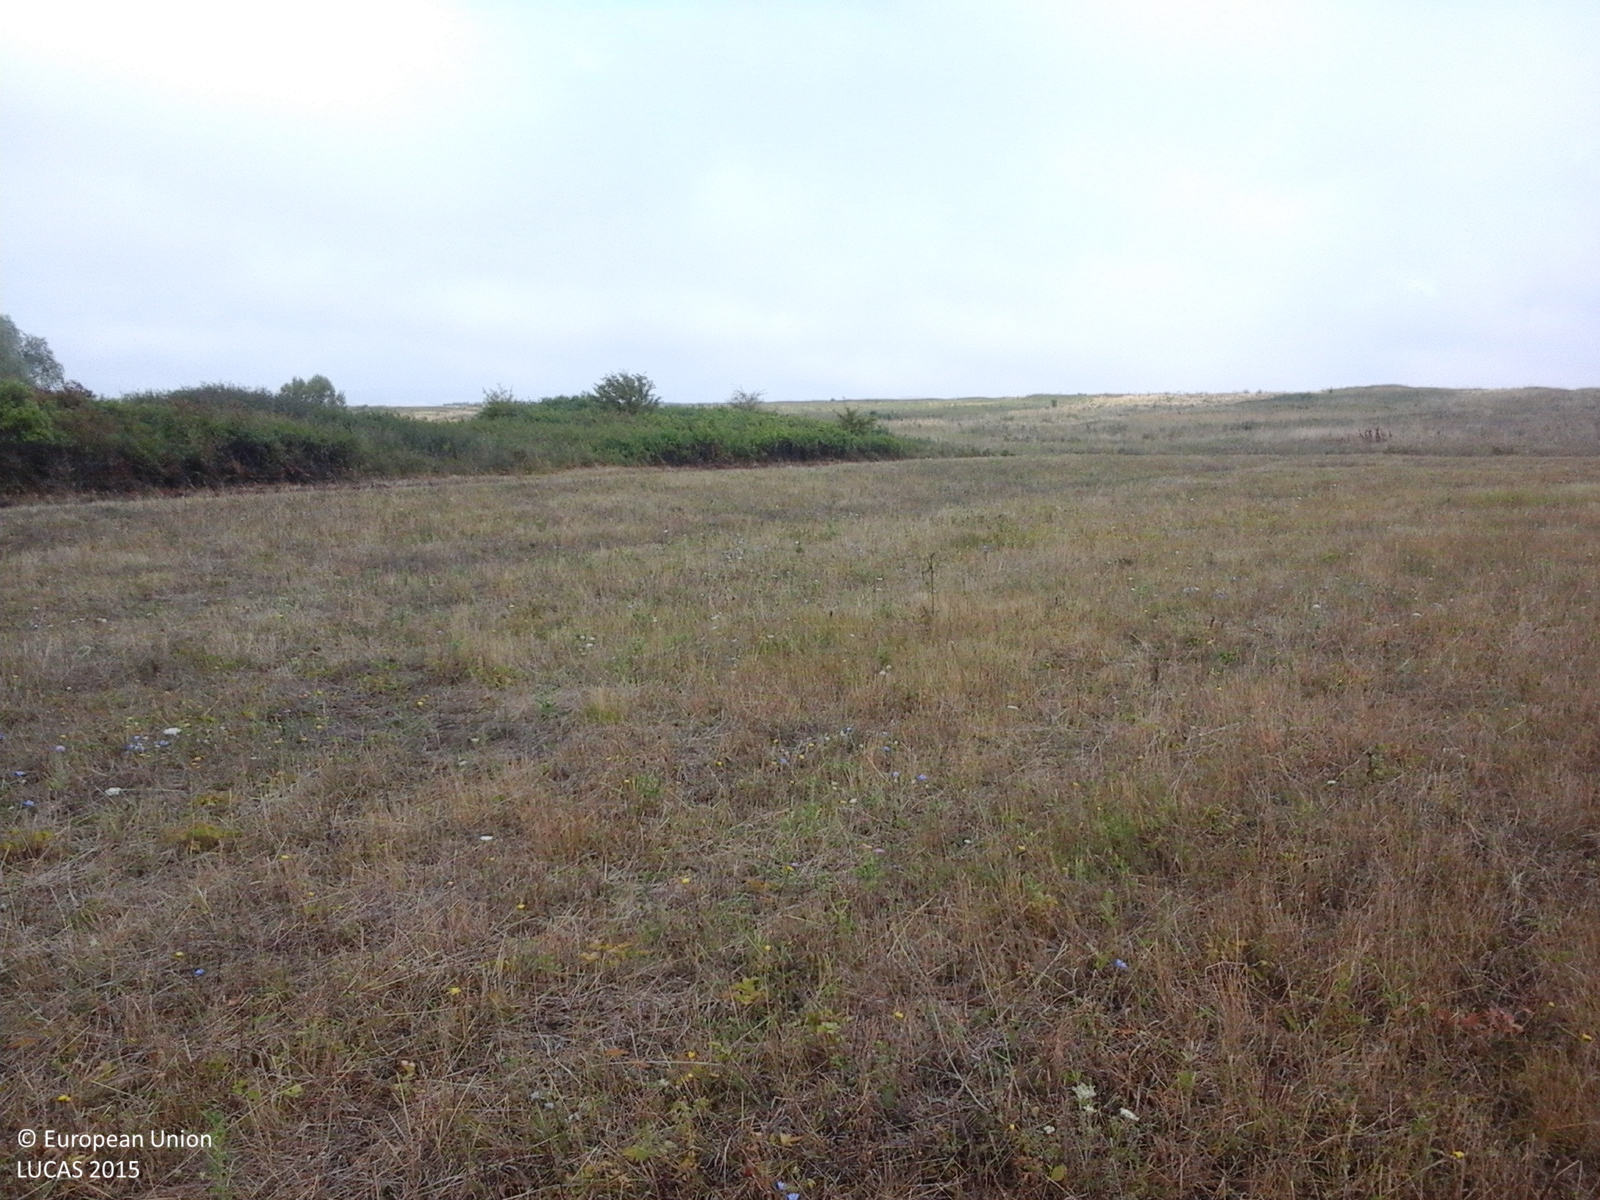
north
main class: Grassland
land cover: Grassland without tree/shrub cover
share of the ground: > 75 %
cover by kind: herbaceous plants 100 %
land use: Agriculture (excluding fallow land and kitchen gardens)
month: August
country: RO
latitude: 44.9822
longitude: 21.5063
